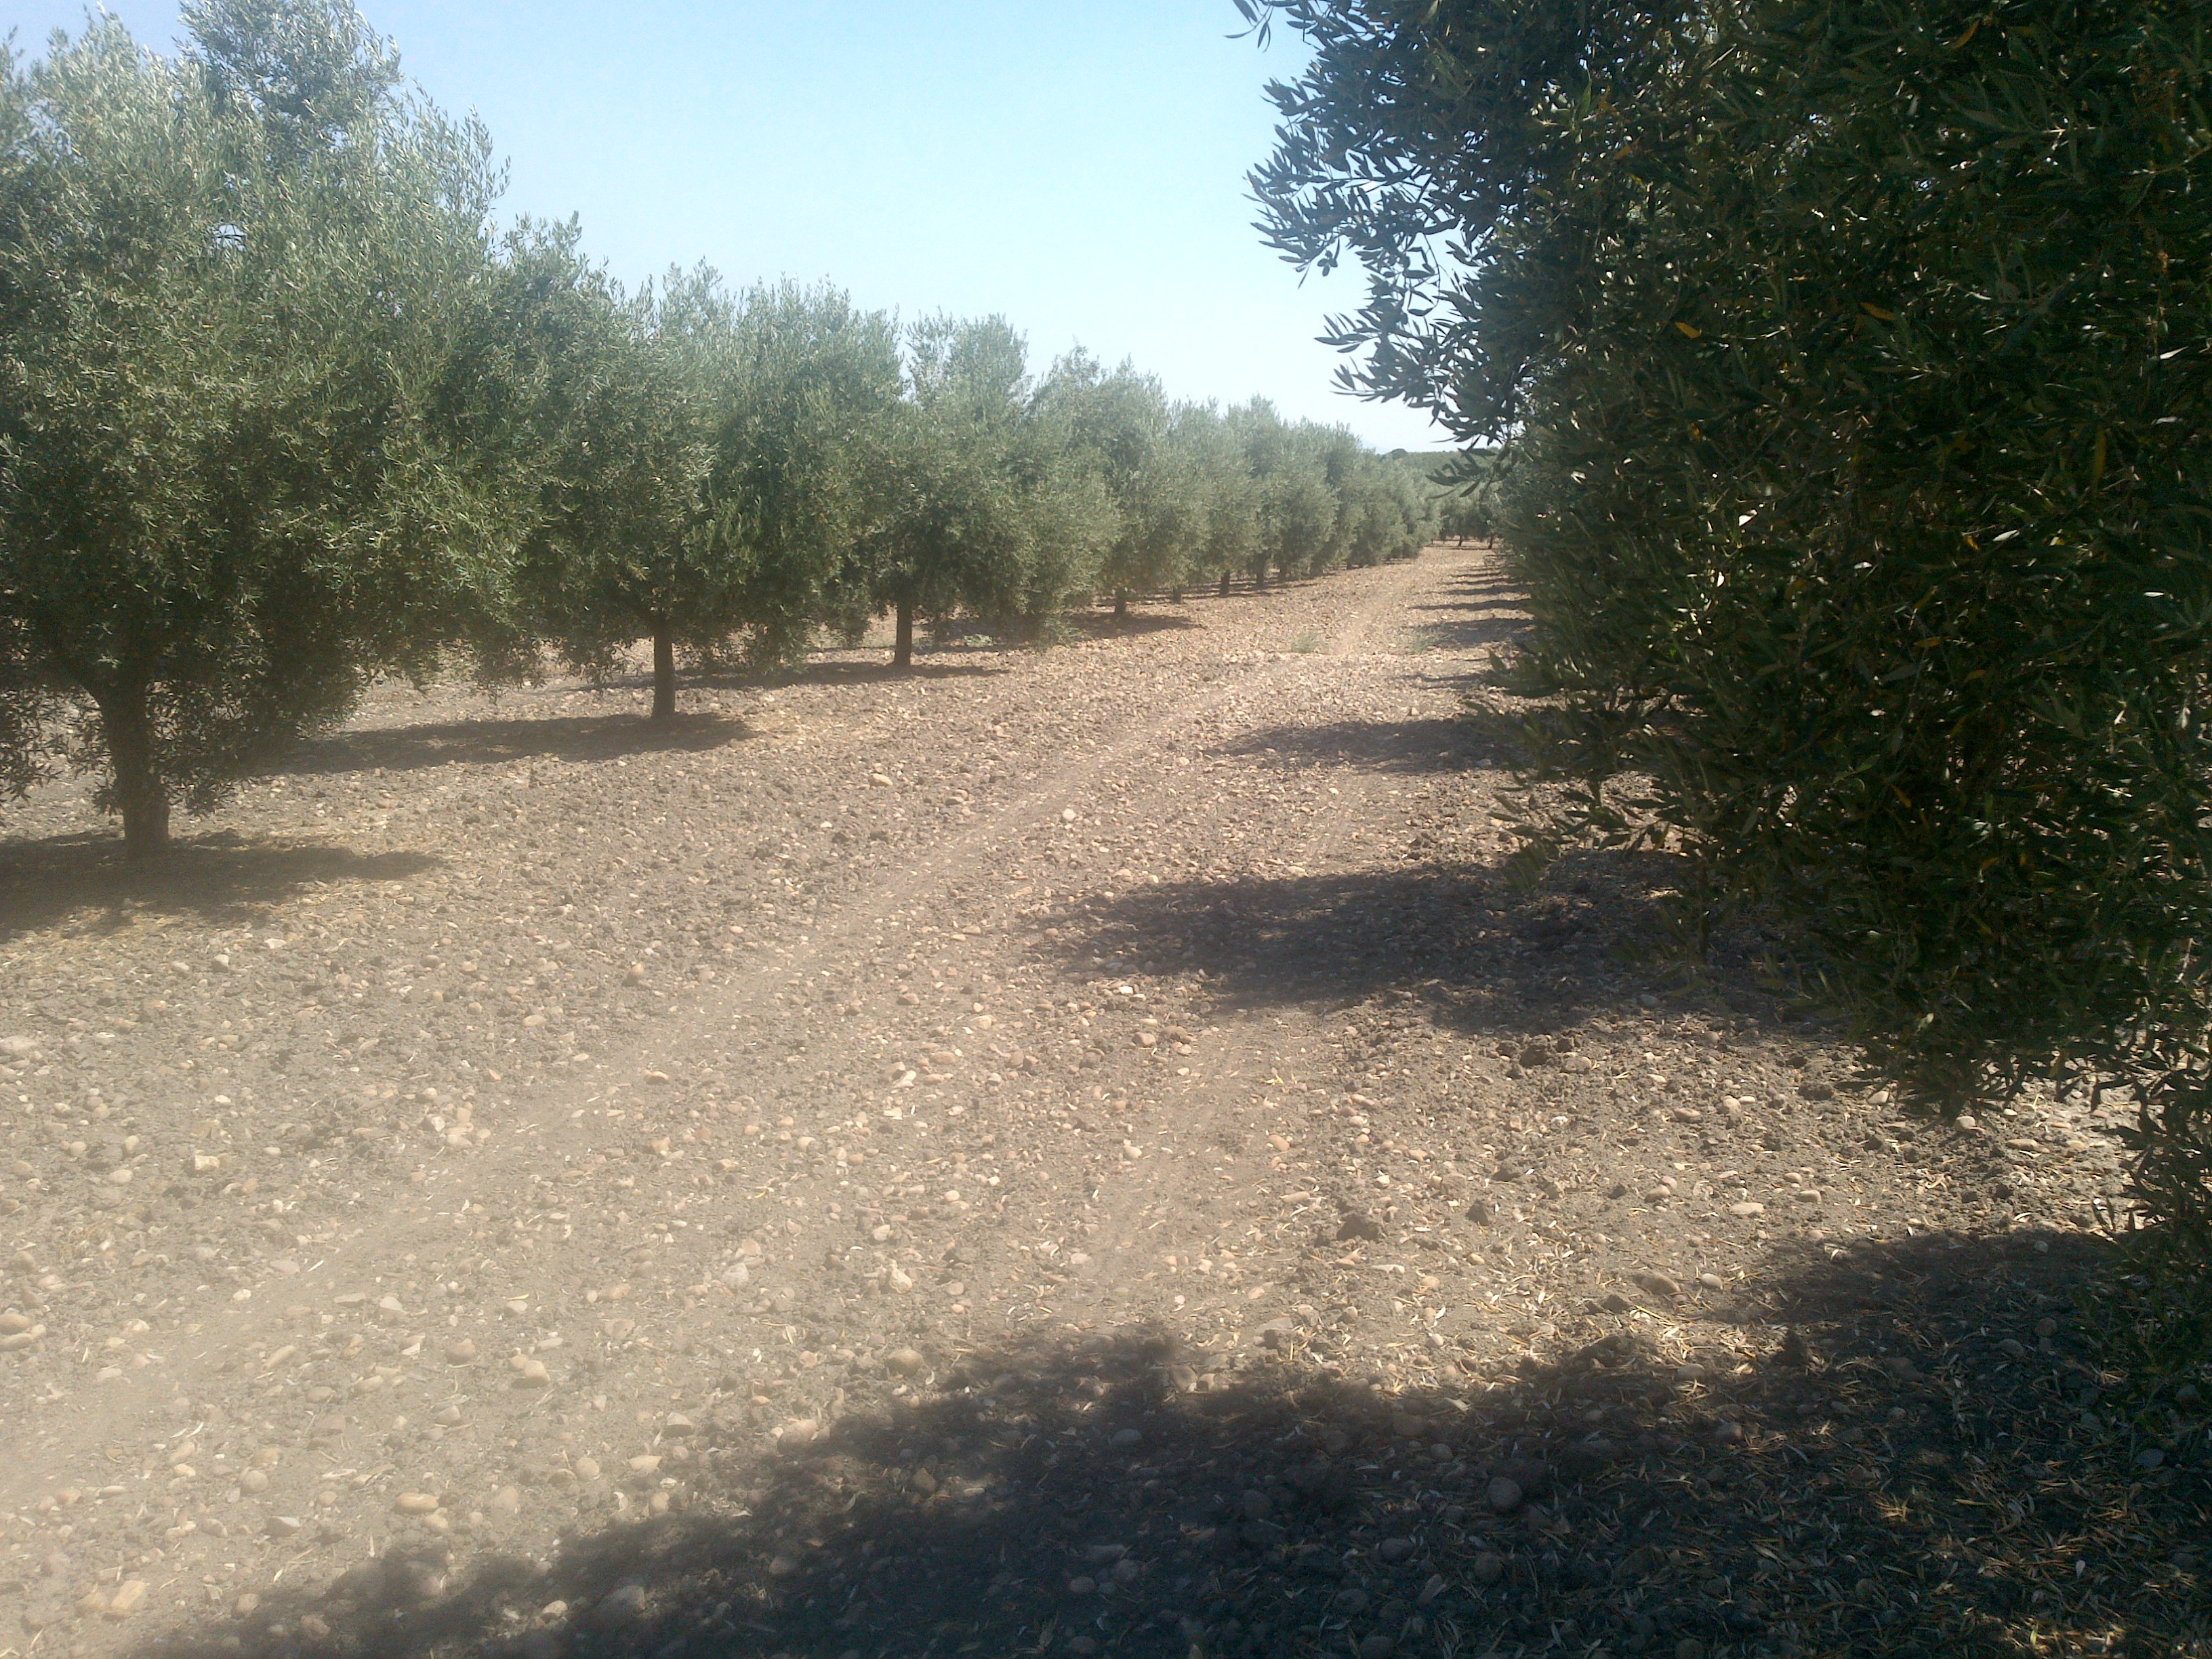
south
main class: Cropland
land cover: Olive groves
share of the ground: 50 - 75 %
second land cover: Other bare soil
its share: > 75 %
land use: Agriculture (excluding fallow land and kitchen gardens)
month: June
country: ES
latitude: 37.5997
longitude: -4.8828
